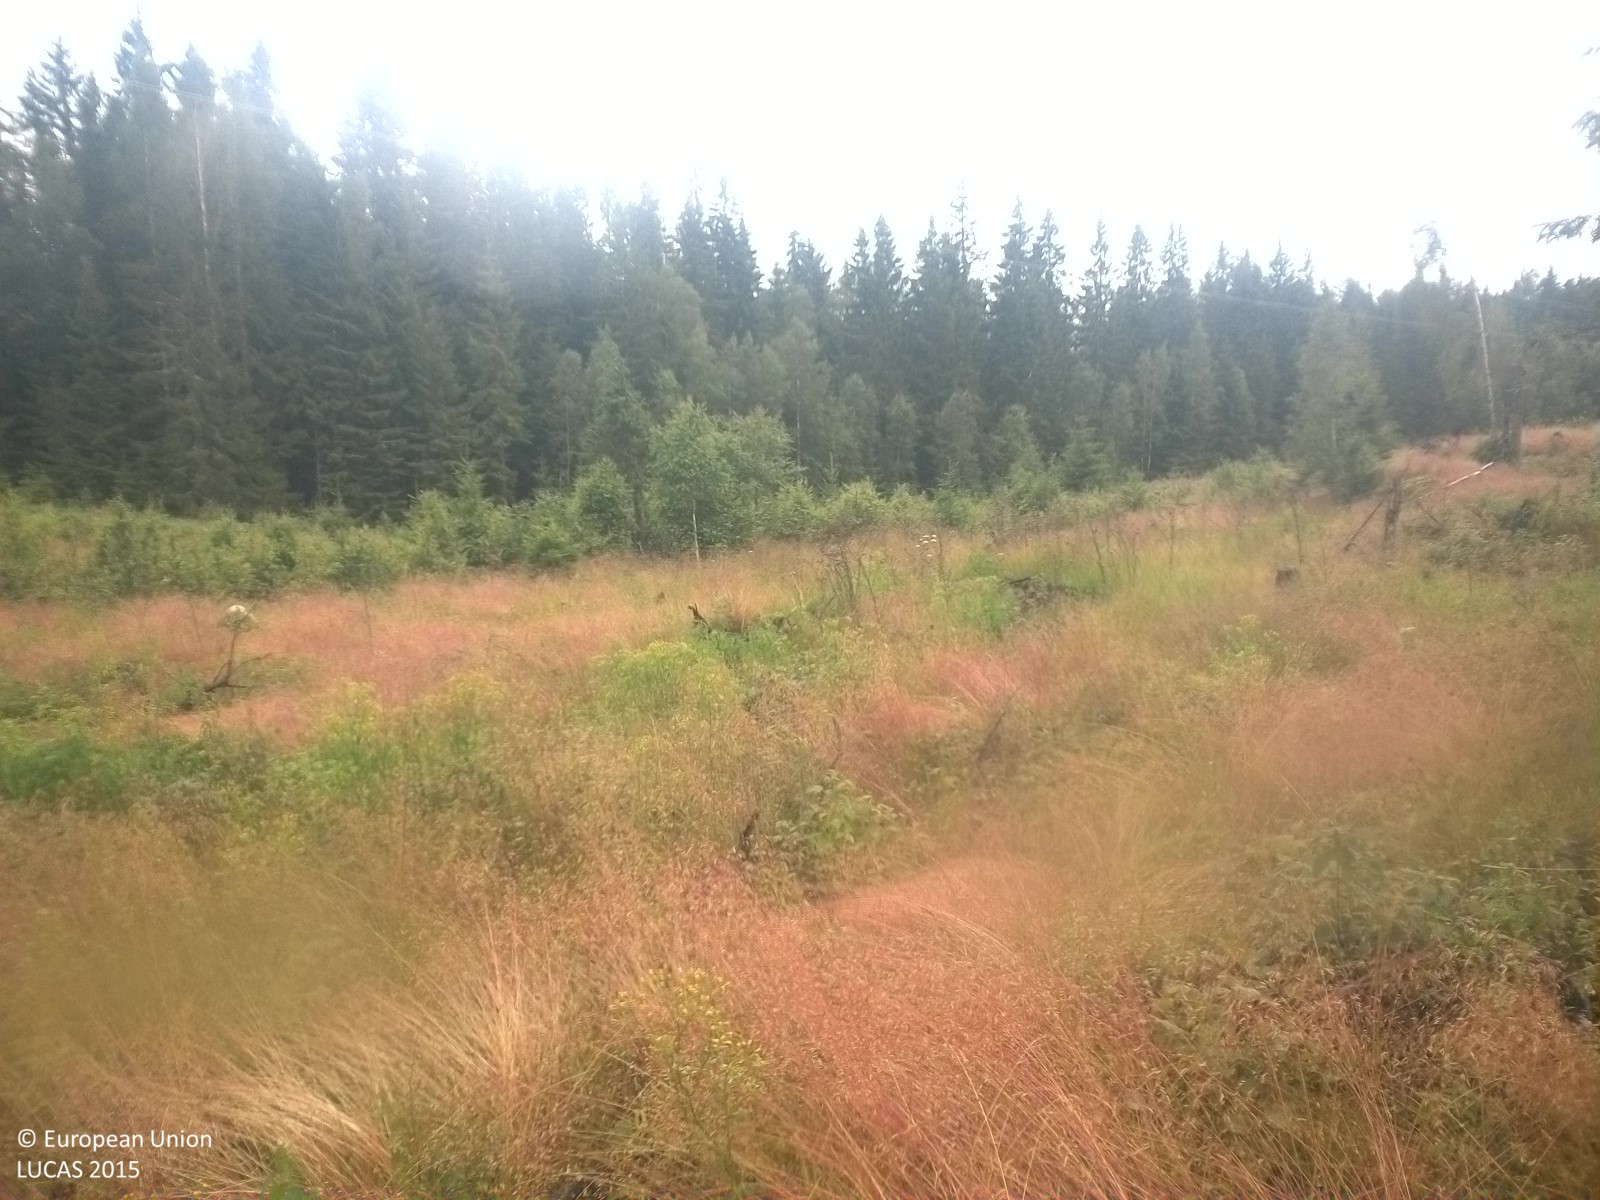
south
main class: Woodland
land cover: Spruce dominated coniferous woodland
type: boreal forest
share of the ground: 10 - 25 %
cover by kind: herbaceous plants 60 %, coniferous forest trees 20 %, shrubs 20 %
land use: Forestry
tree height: < 5 m
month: July
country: SE
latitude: 58.9973
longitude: 14.8486
